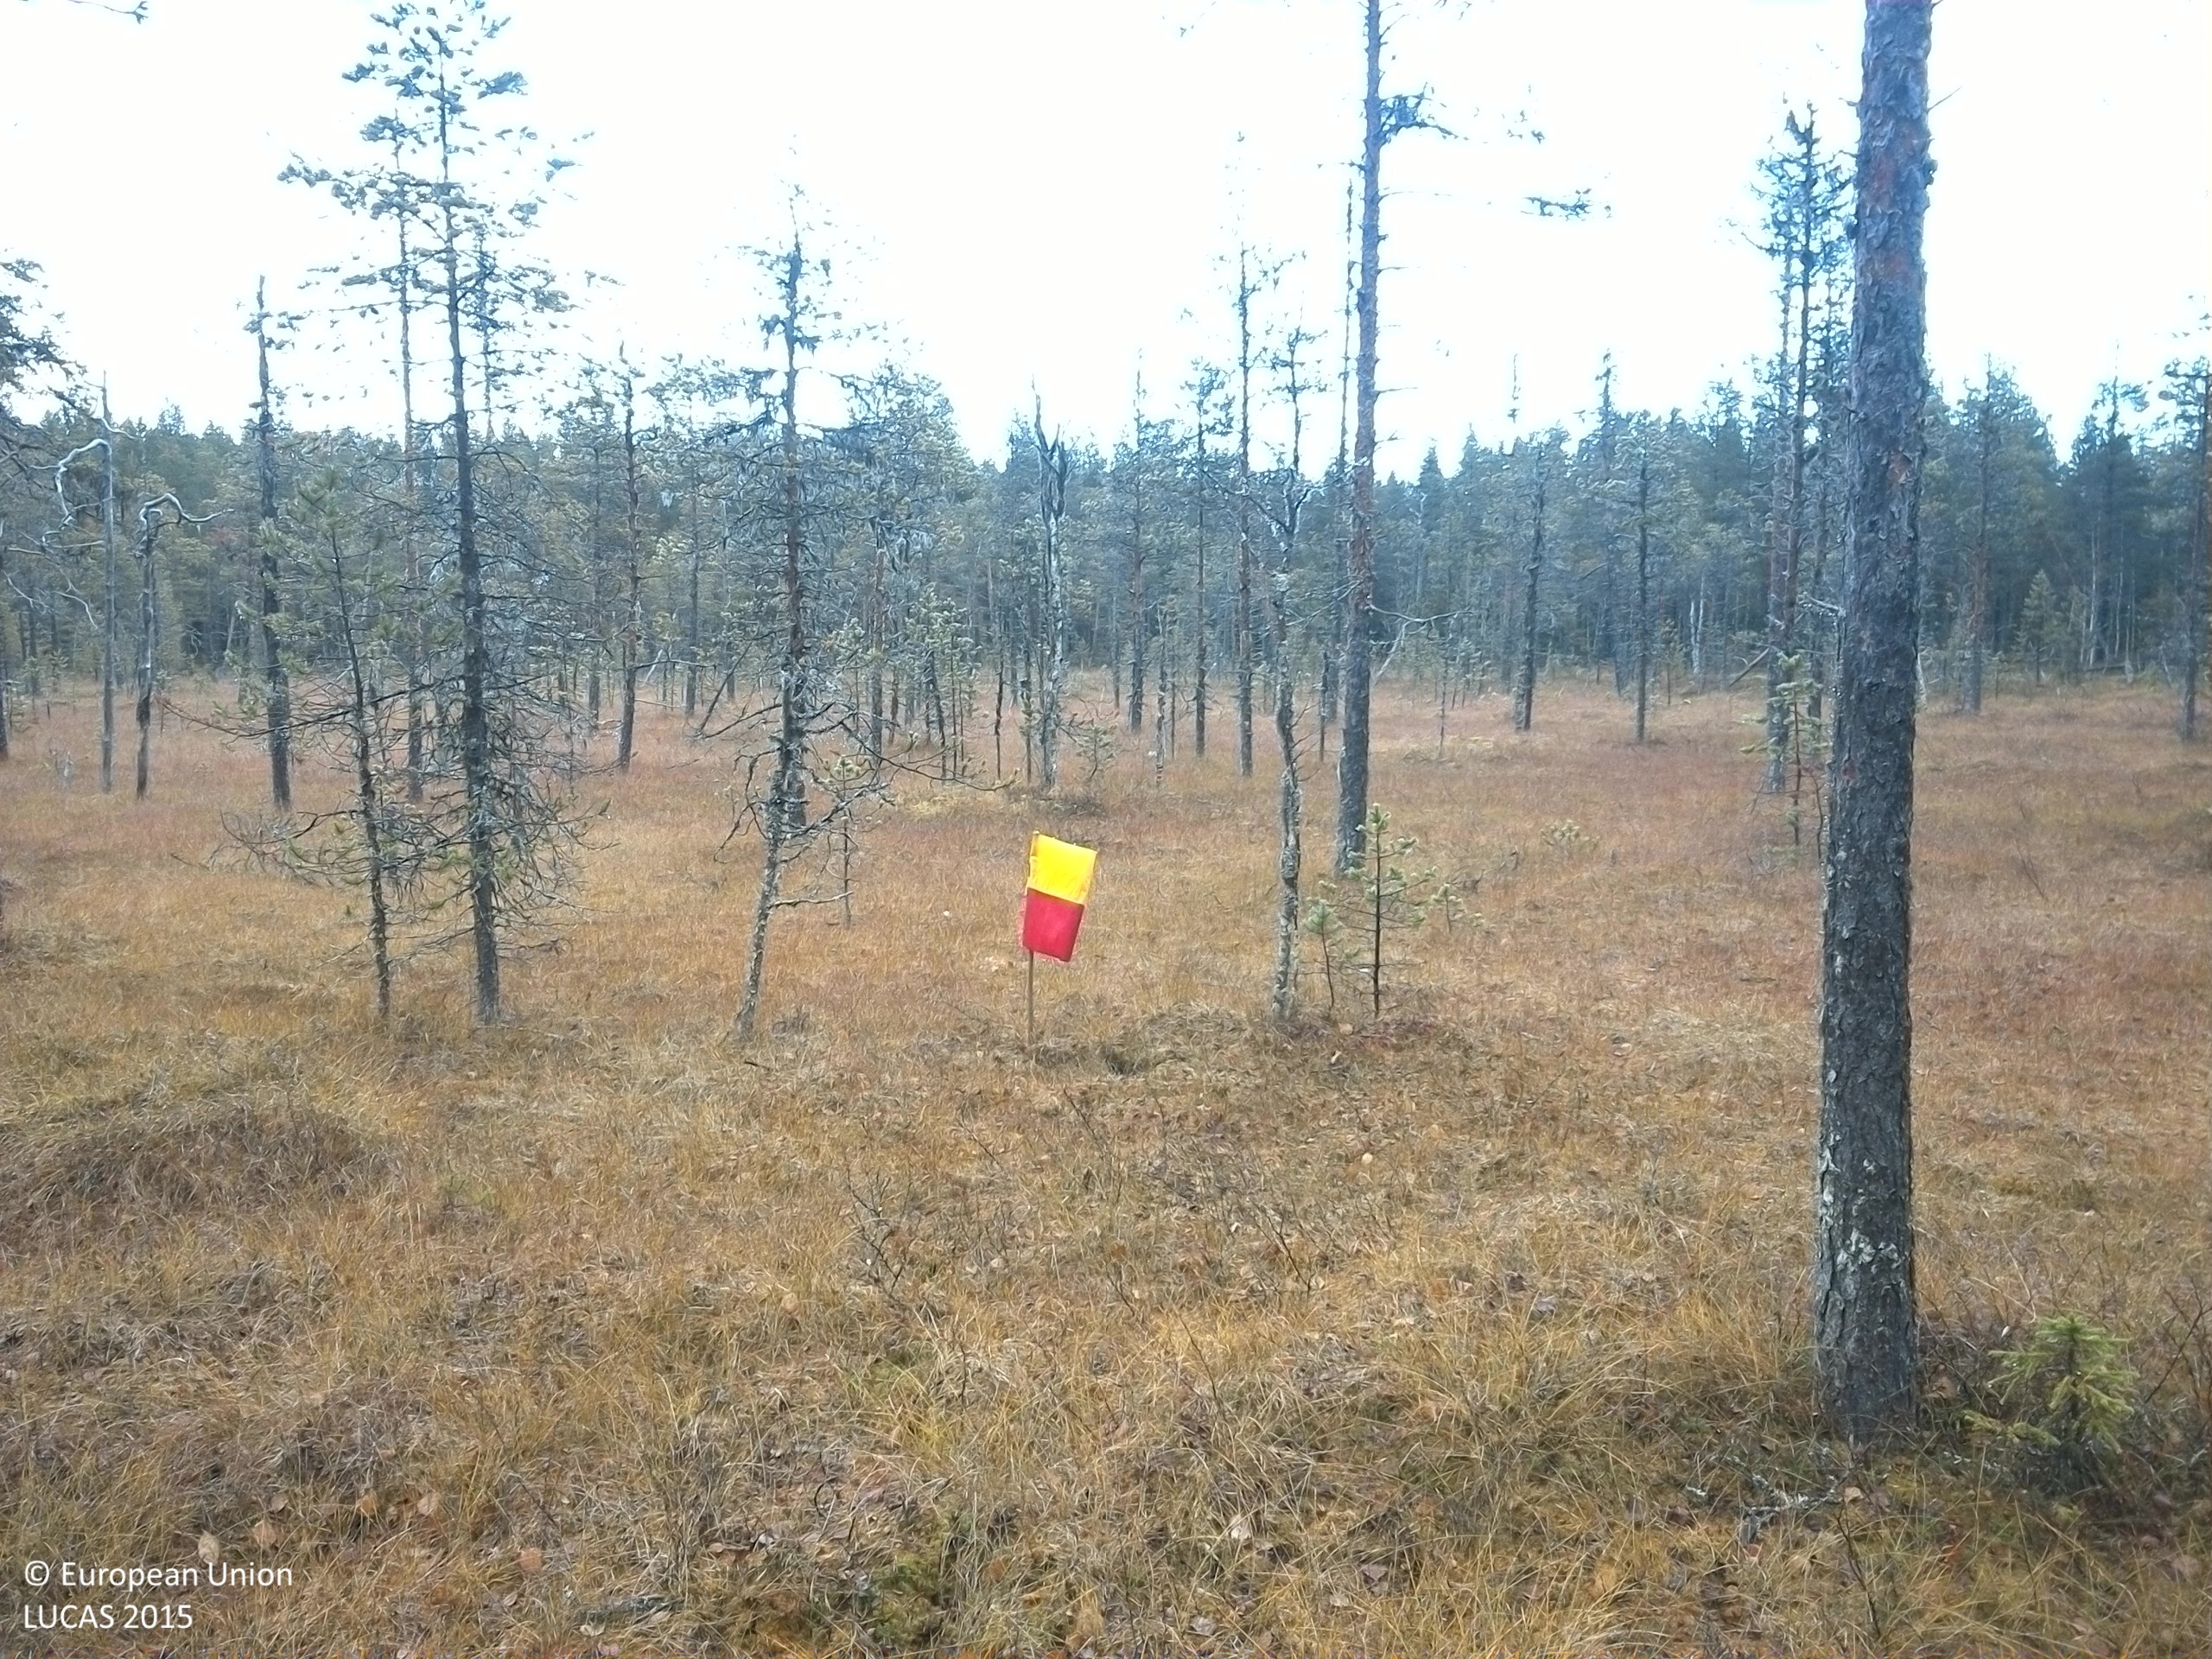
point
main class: Woodland
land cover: Pine dominated mixed woodland
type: mire and swamp forests
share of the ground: 10 - 25 %
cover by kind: herbaceous plants 35 %, lichens and mosses 35 %, coniferous forest trees 15 %, shrubs 10 %, broadleaved forest trees 5 %
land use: Semi-natural and natural areas not in use
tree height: > 5 m
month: October
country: SE
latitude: 64.0503
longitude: 15.9728
